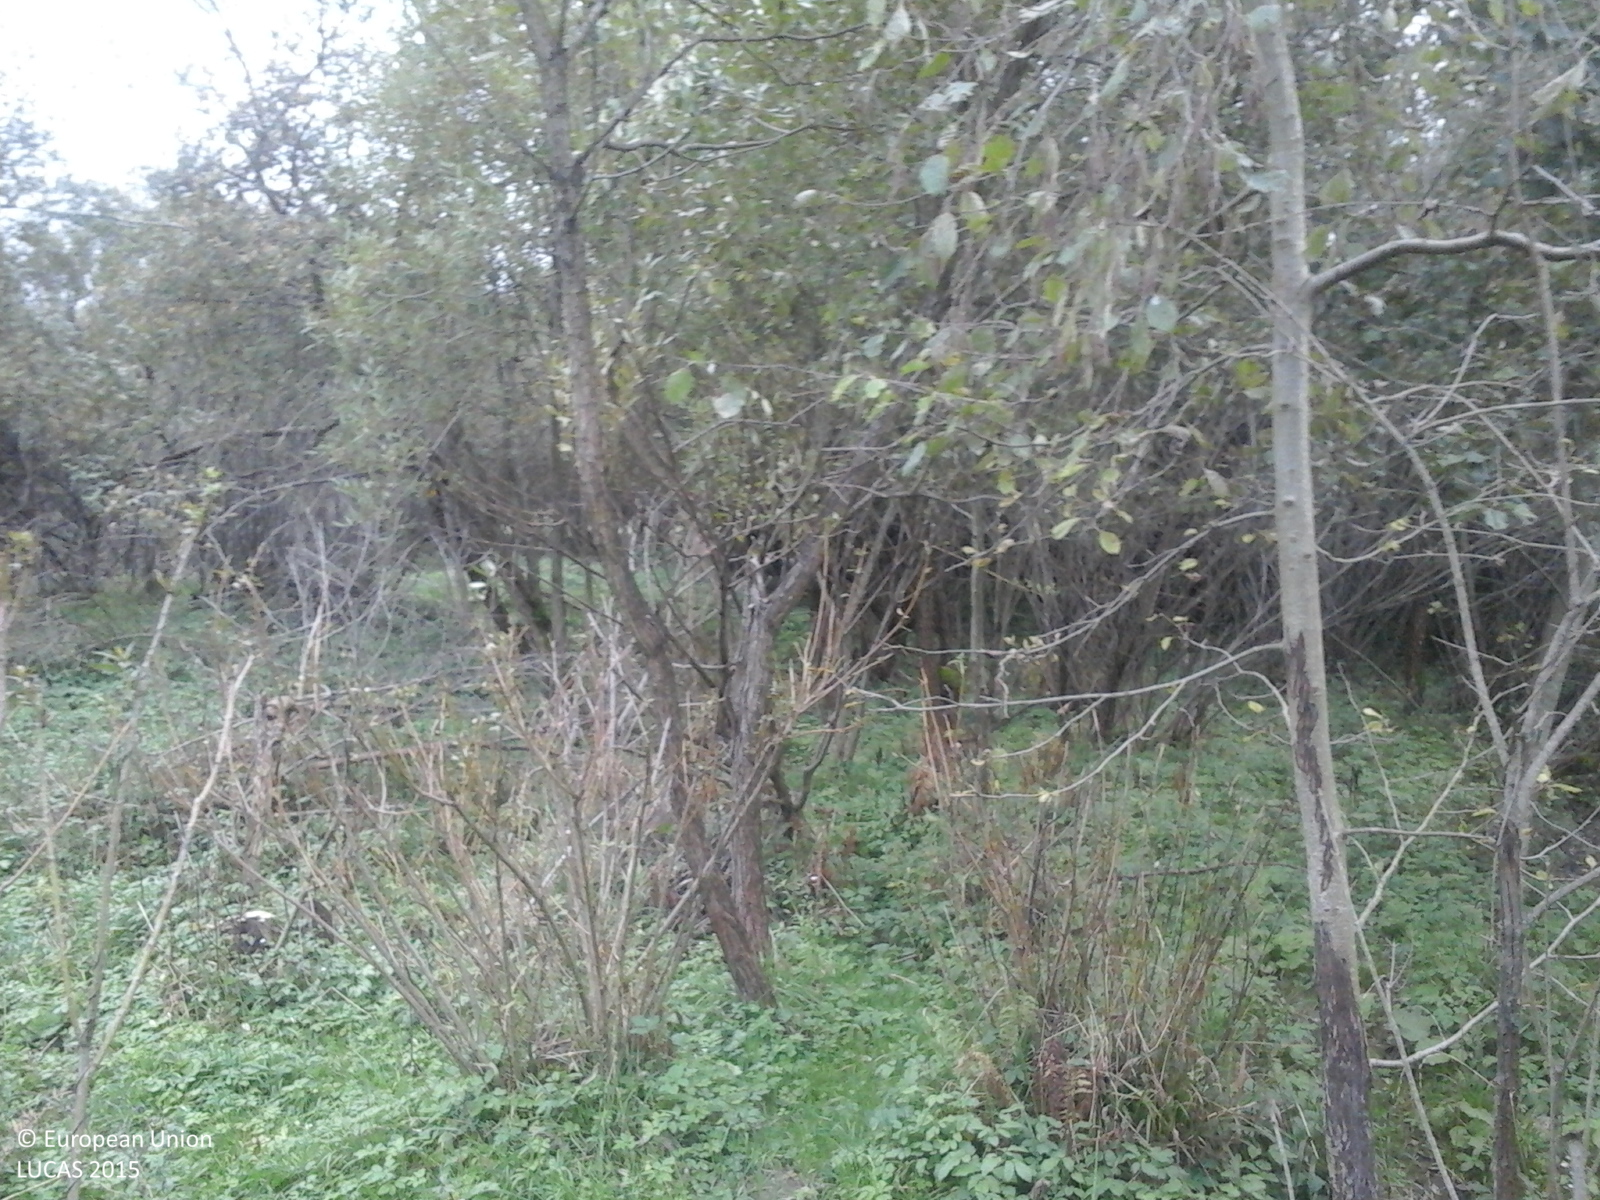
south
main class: Woodland
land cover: Other mixed woodland
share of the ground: > 75 %
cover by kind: broadleaved forest trees 65 %, coniferous forest trees 25 %, herbaceous plants 10 %
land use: Forestry
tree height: < 5 m
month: October
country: RO
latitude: 45.7140
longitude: 24.8225
